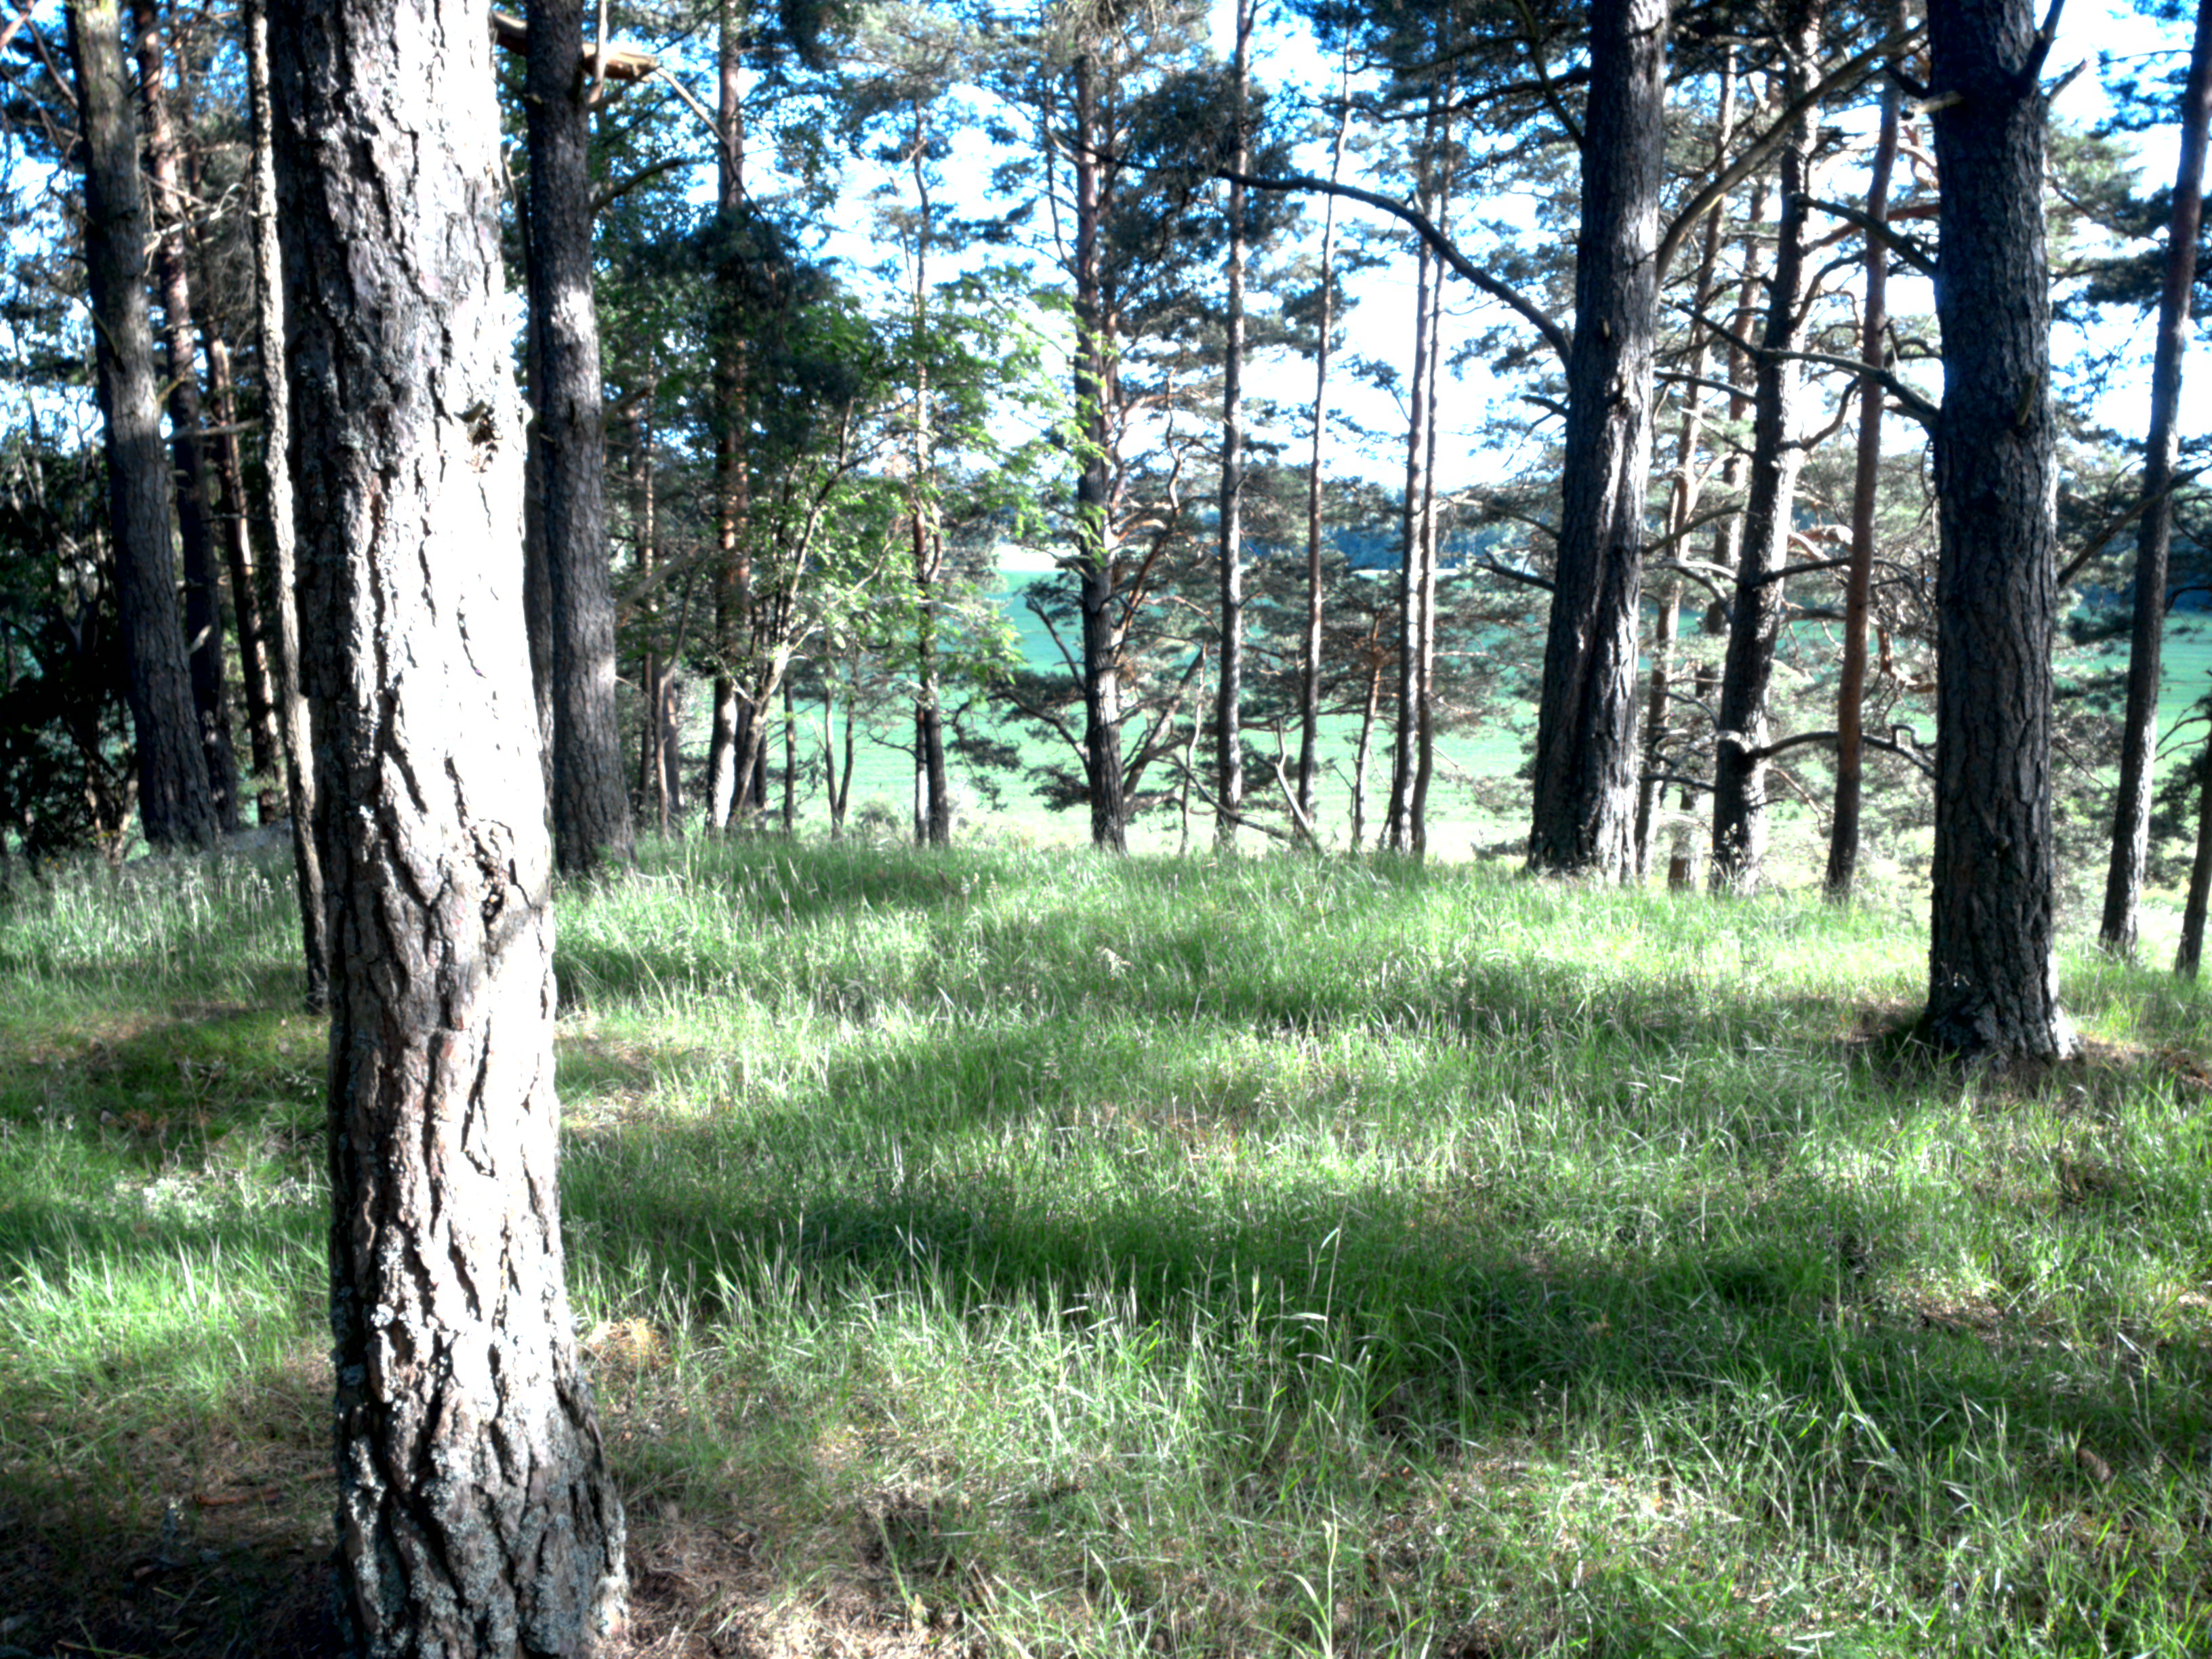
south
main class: Woodland
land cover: Pine dominated coniferous woodland
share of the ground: 50 - 75 %
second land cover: Grassland without tree/shrub cover
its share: 25 - 50 %
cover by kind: coniferous forest trees 50 %, herbaceous plants 30 %, broadleaved forest trees 10 %, shrubs 10 %
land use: Forestry
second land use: Agriculture (excluding fallow land and kitchen gardens)
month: June
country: SE
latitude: 59.2084
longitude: 17.4045
